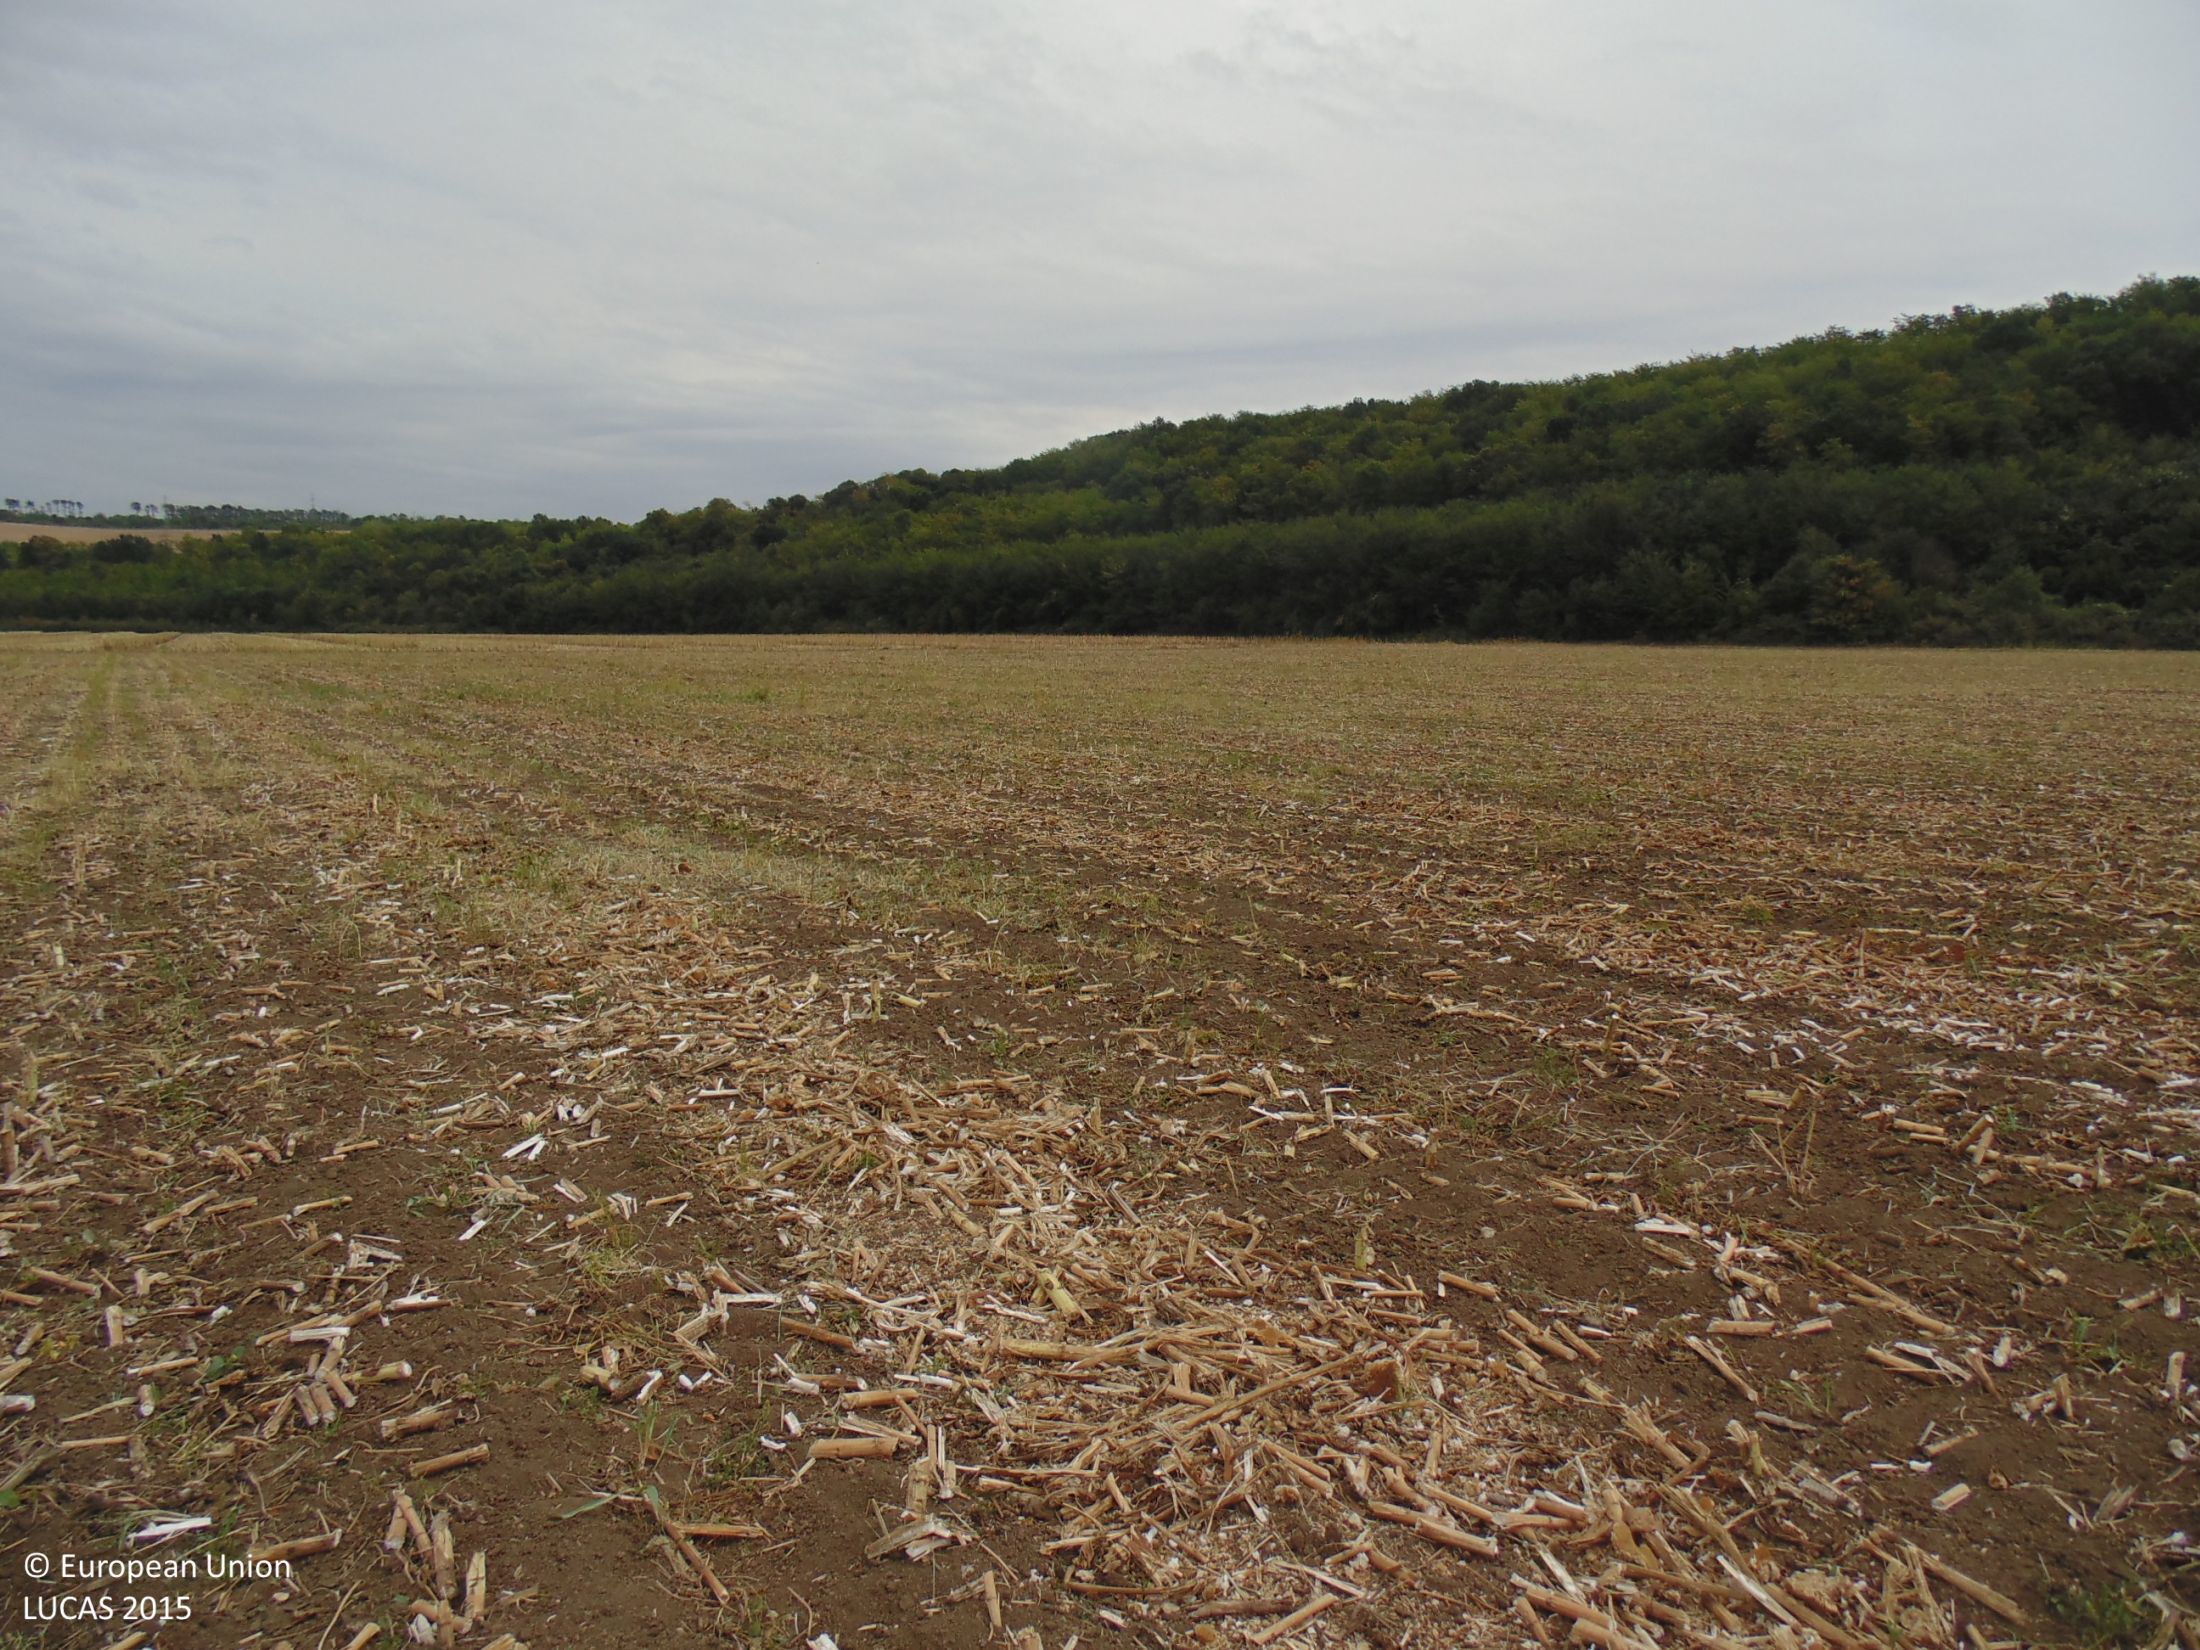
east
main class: Cropland
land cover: Sunflower
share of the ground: < 10 %
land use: Agriculture (excluding fallow land and kitchen gardens)
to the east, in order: Sunflower; Grass margins; Sunflower
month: September
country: BG
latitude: 44.0327
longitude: 26.9293
